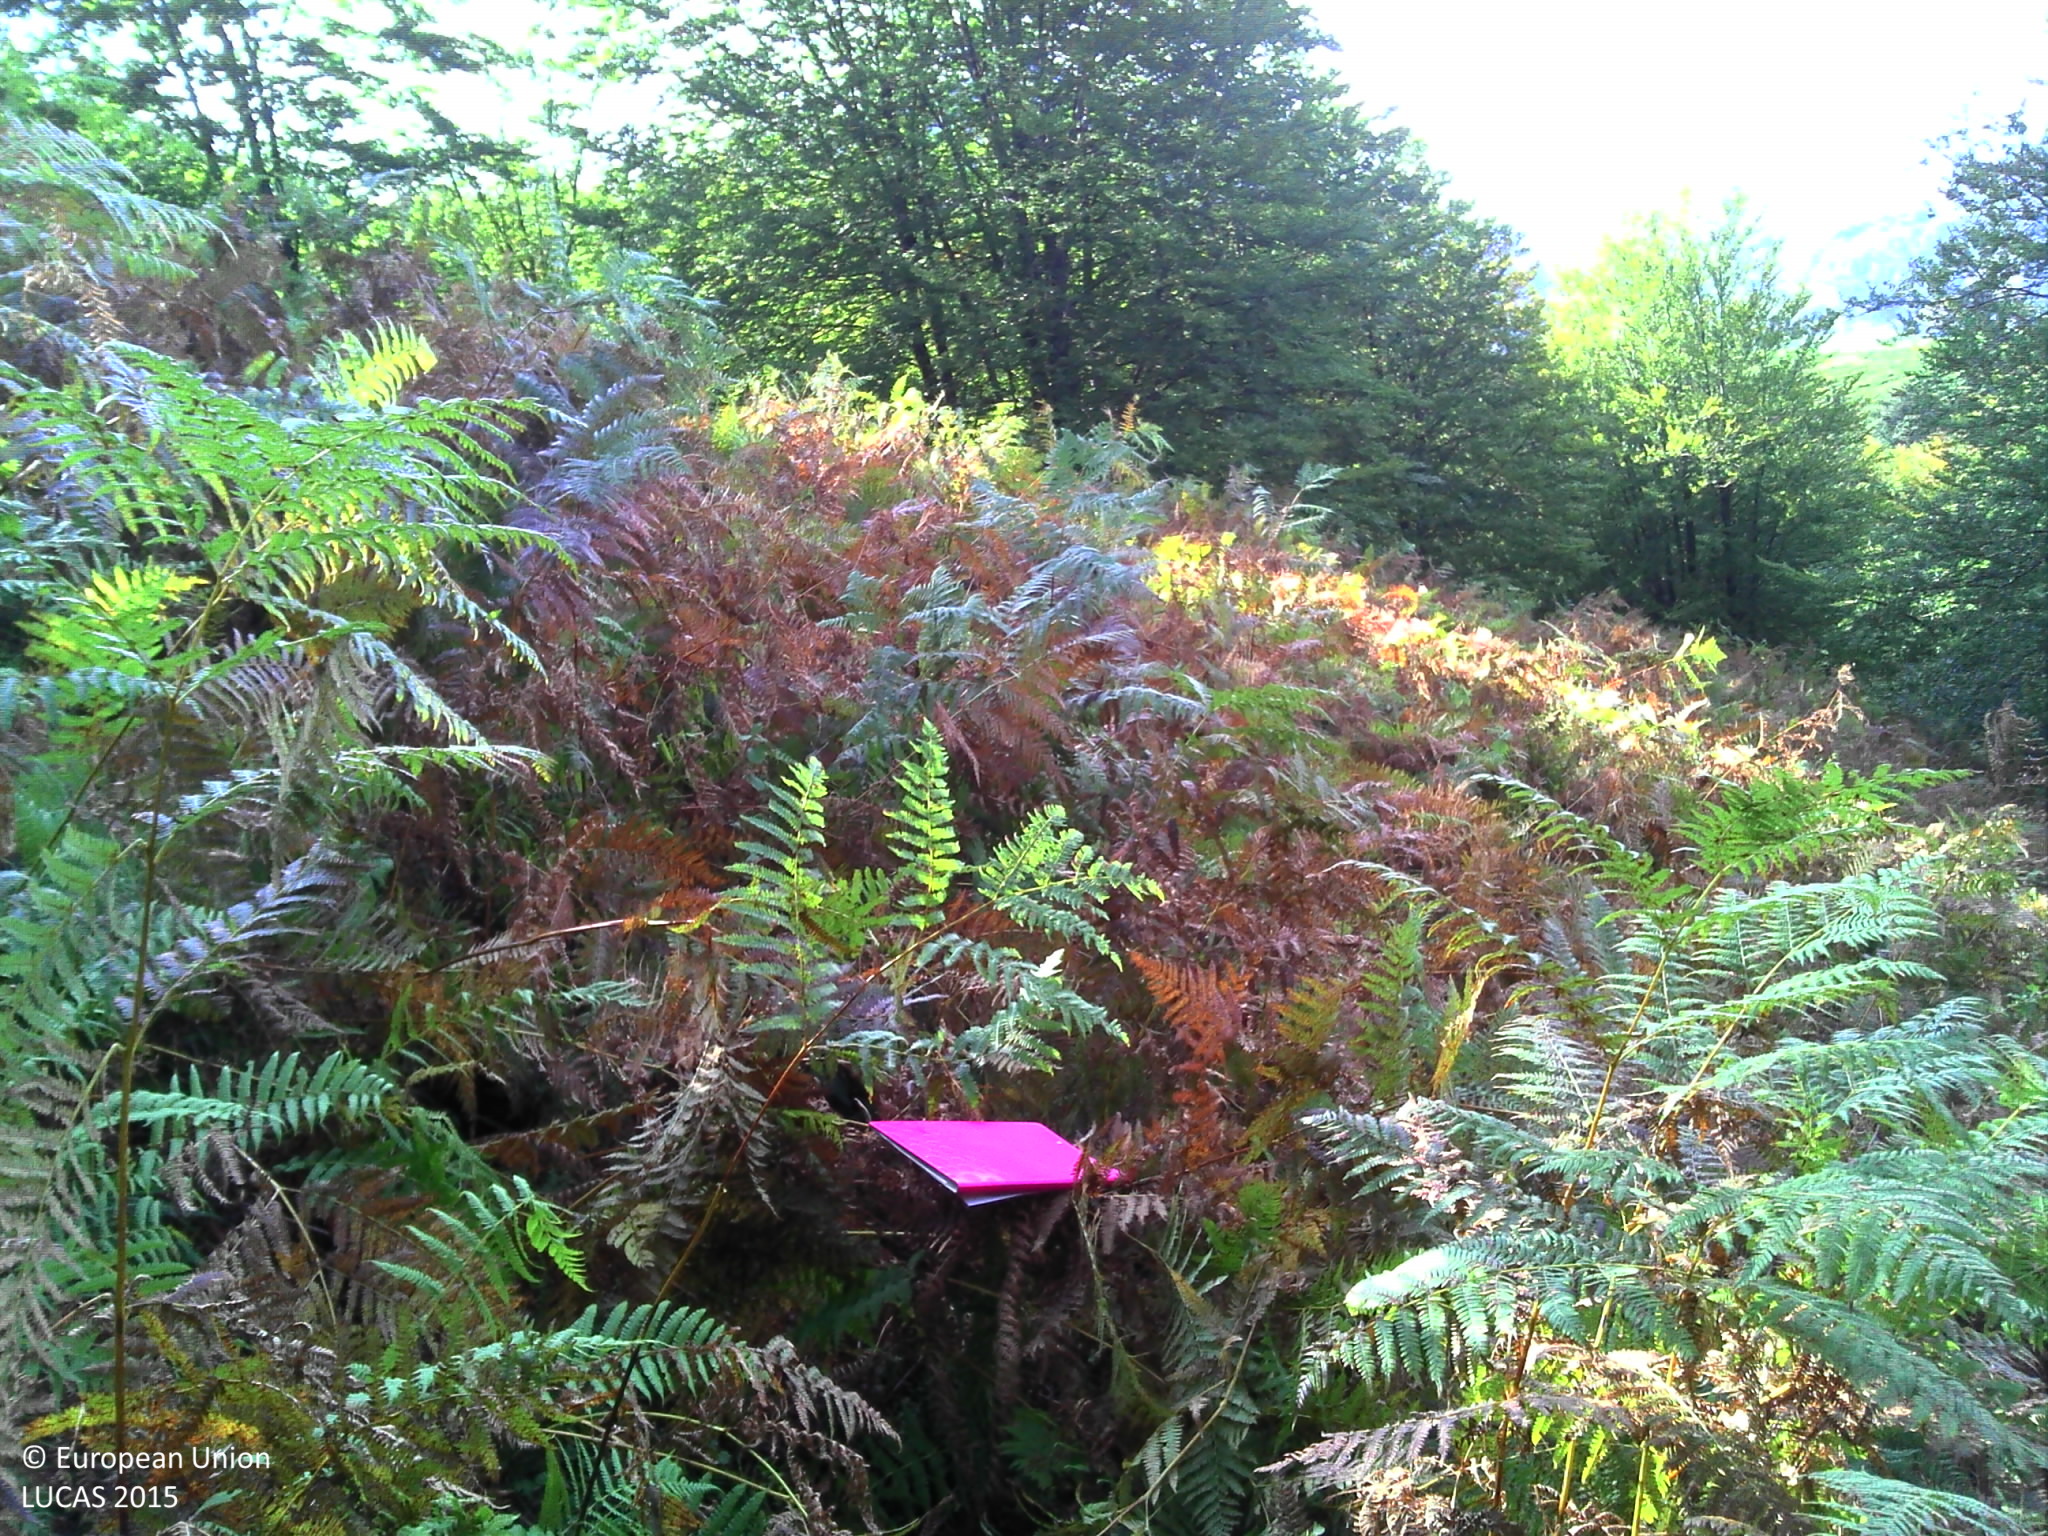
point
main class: Grassland
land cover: Spontaneously vegetated surfaces
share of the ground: > 75 %
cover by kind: herbaceous plants 95 %, shrubs 5 %
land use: Abandoned areas
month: September
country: FR
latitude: 43.0373
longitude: -0.6488
